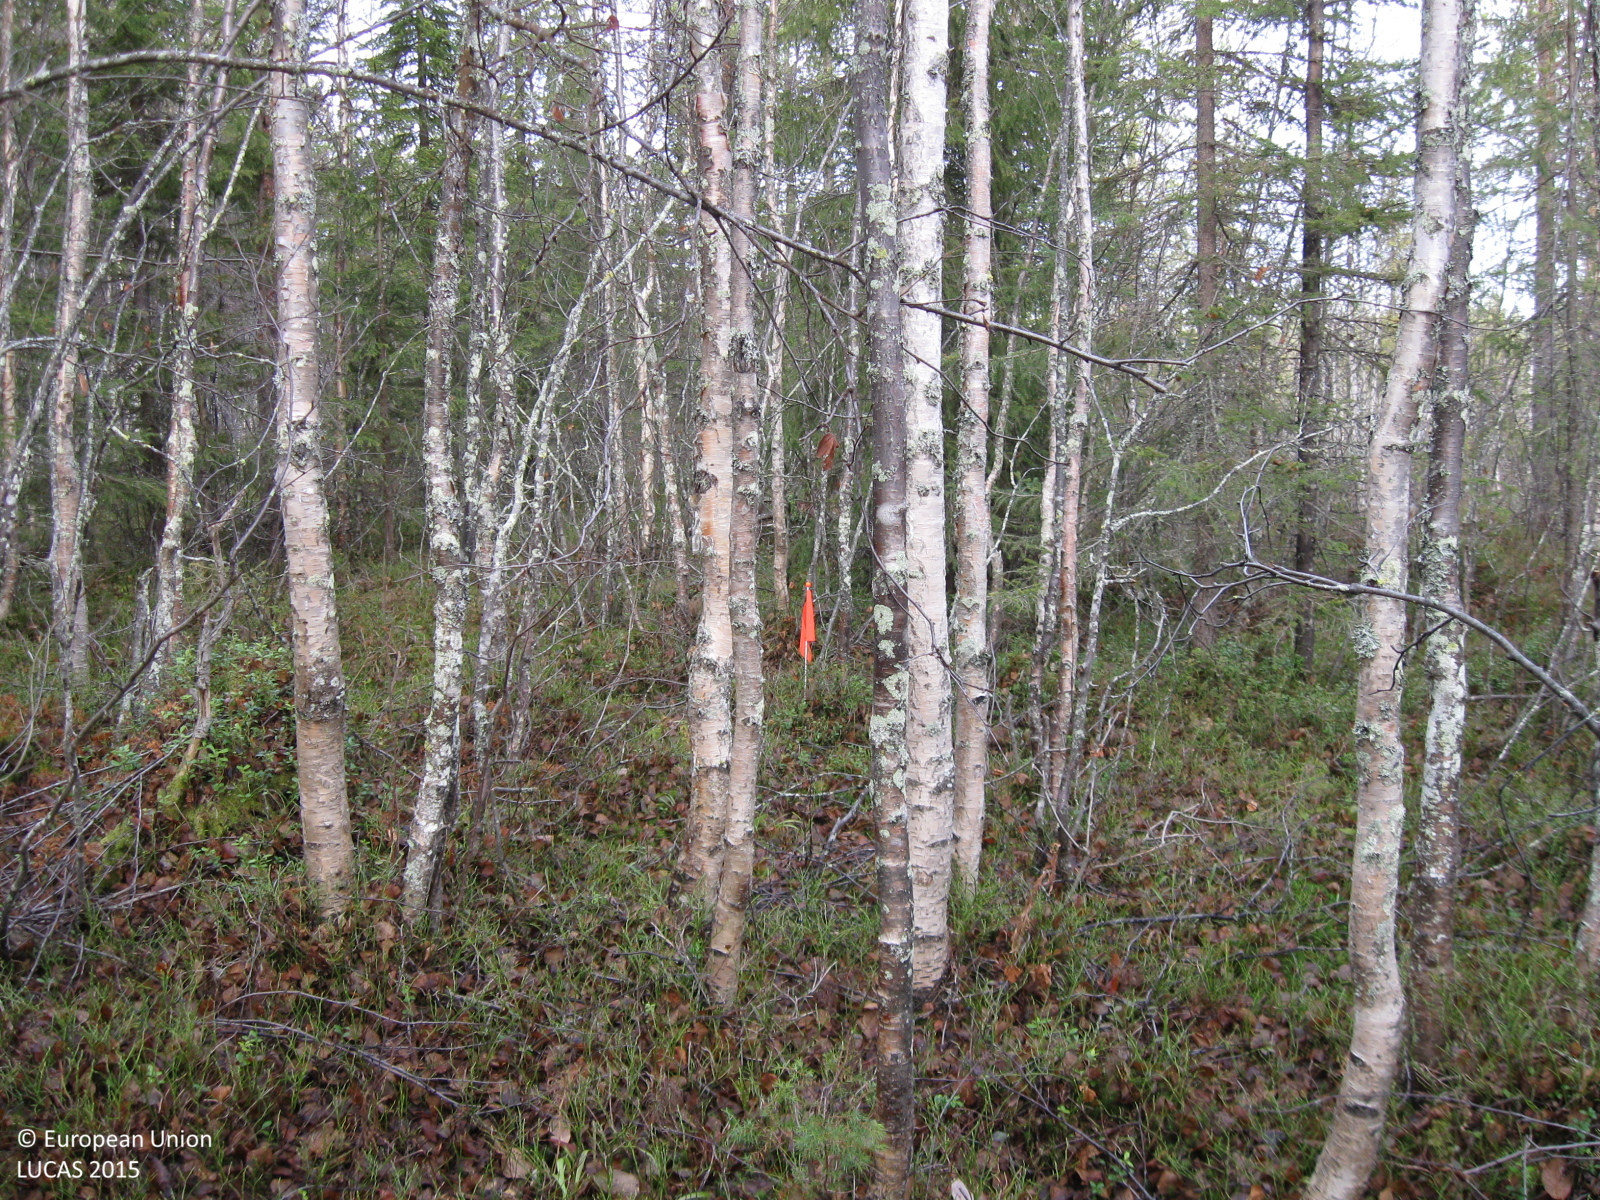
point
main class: Woodland
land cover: Broadleaved woodland
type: mire and swamp forests
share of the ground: > 75 %
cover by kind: broadleaved forest trees 70 %, coniferous forest trees 15 %, shrubs 5 %, herbaceous plants 5 %, lichens and mosses 5 %
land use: Forestry
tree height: > 5 m
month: October
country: SE
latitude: 66.5768
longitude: 21.7993
